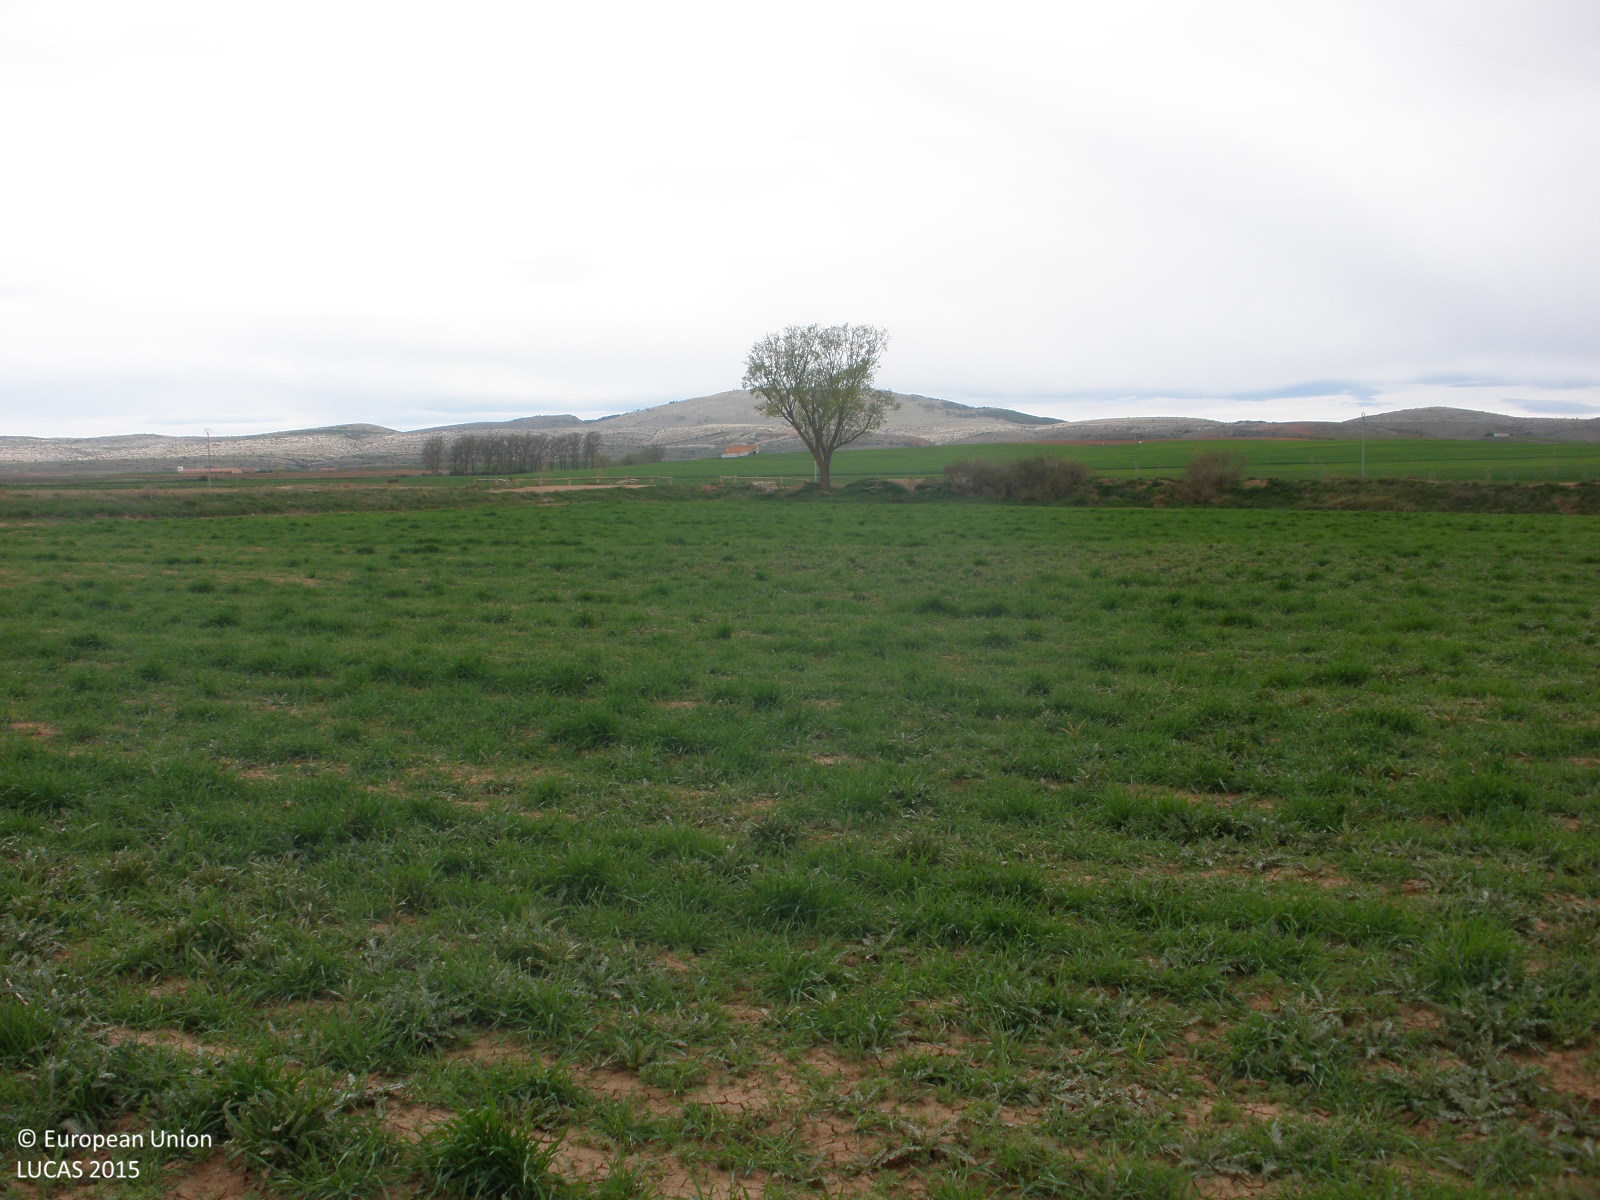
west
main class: Cropland
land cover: Barley
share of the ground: > 75 %
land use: Agriculture (excluding fallow land and kitchen gardens)
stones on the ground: < 10 %
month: May
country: ES
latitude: 40.4842
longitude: -0.8518
